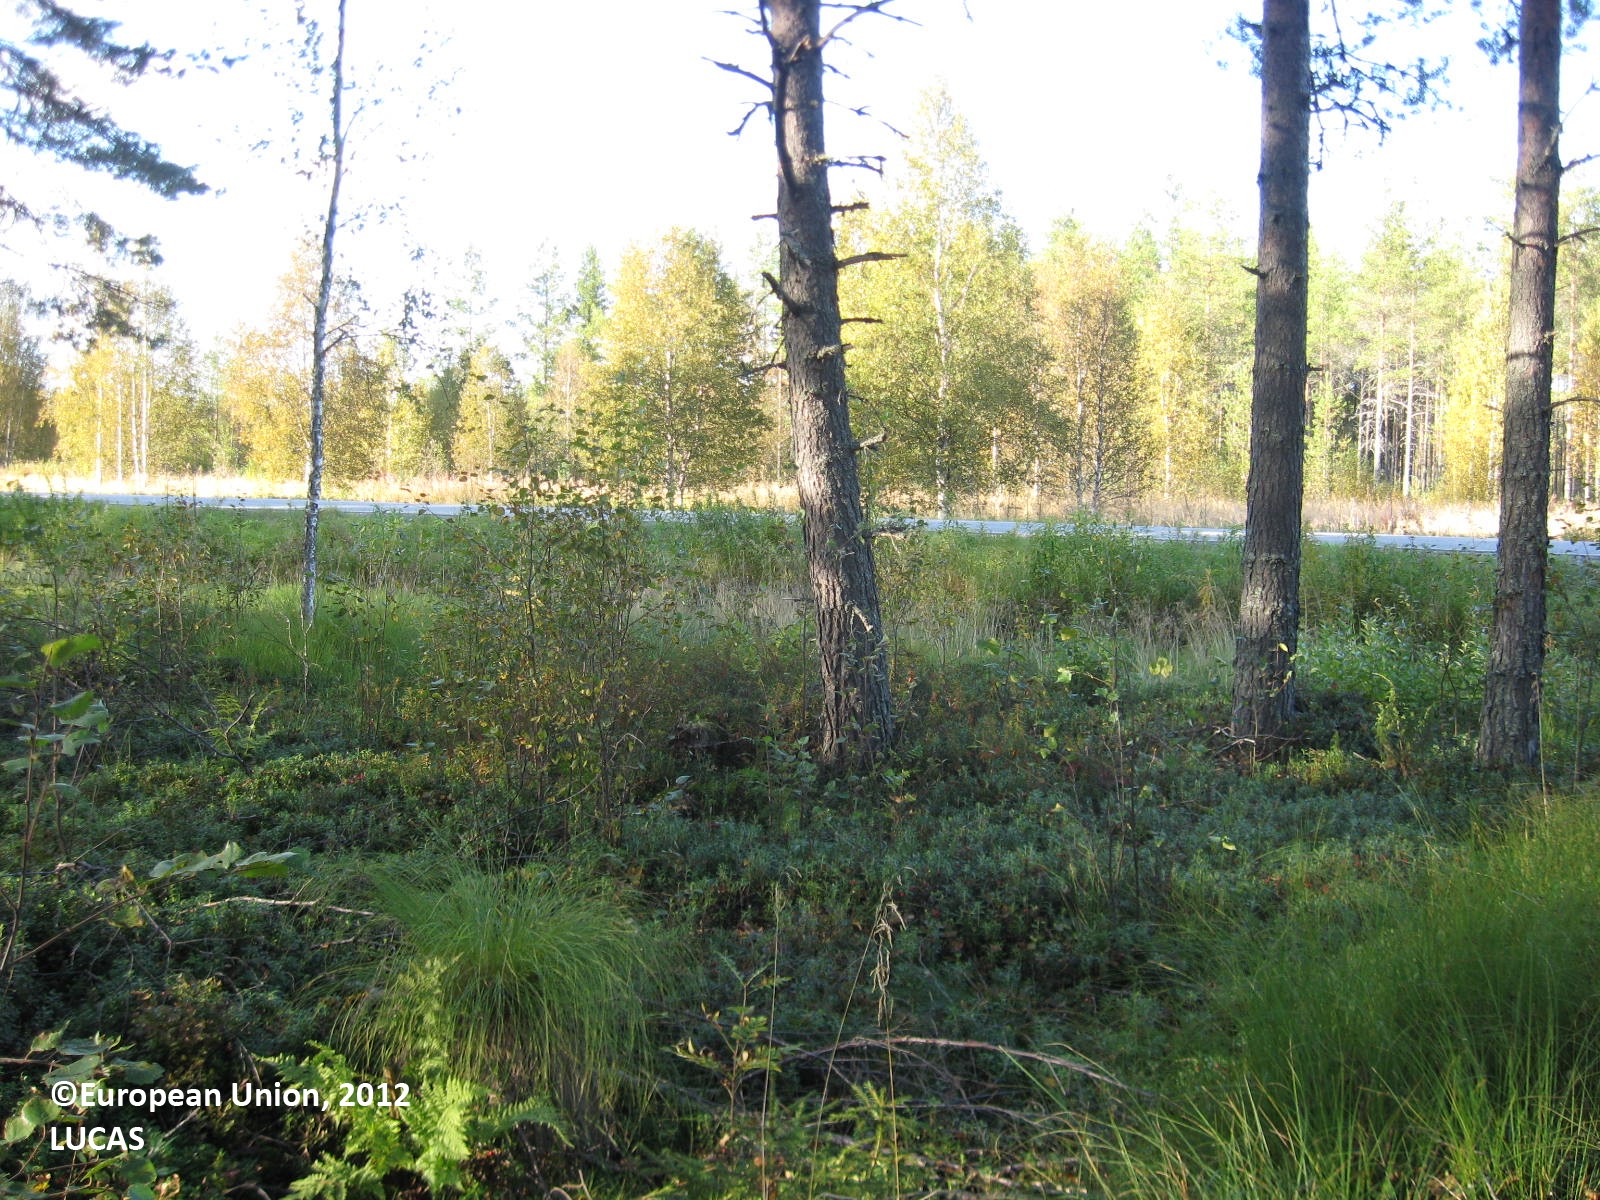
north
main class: Woodland
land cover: Other mixed woodland
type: boreal forest
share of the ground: > 75 %
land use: Forestry
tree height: > 5 m
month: August
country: FI
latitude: 63.9728
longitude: 29.6521
